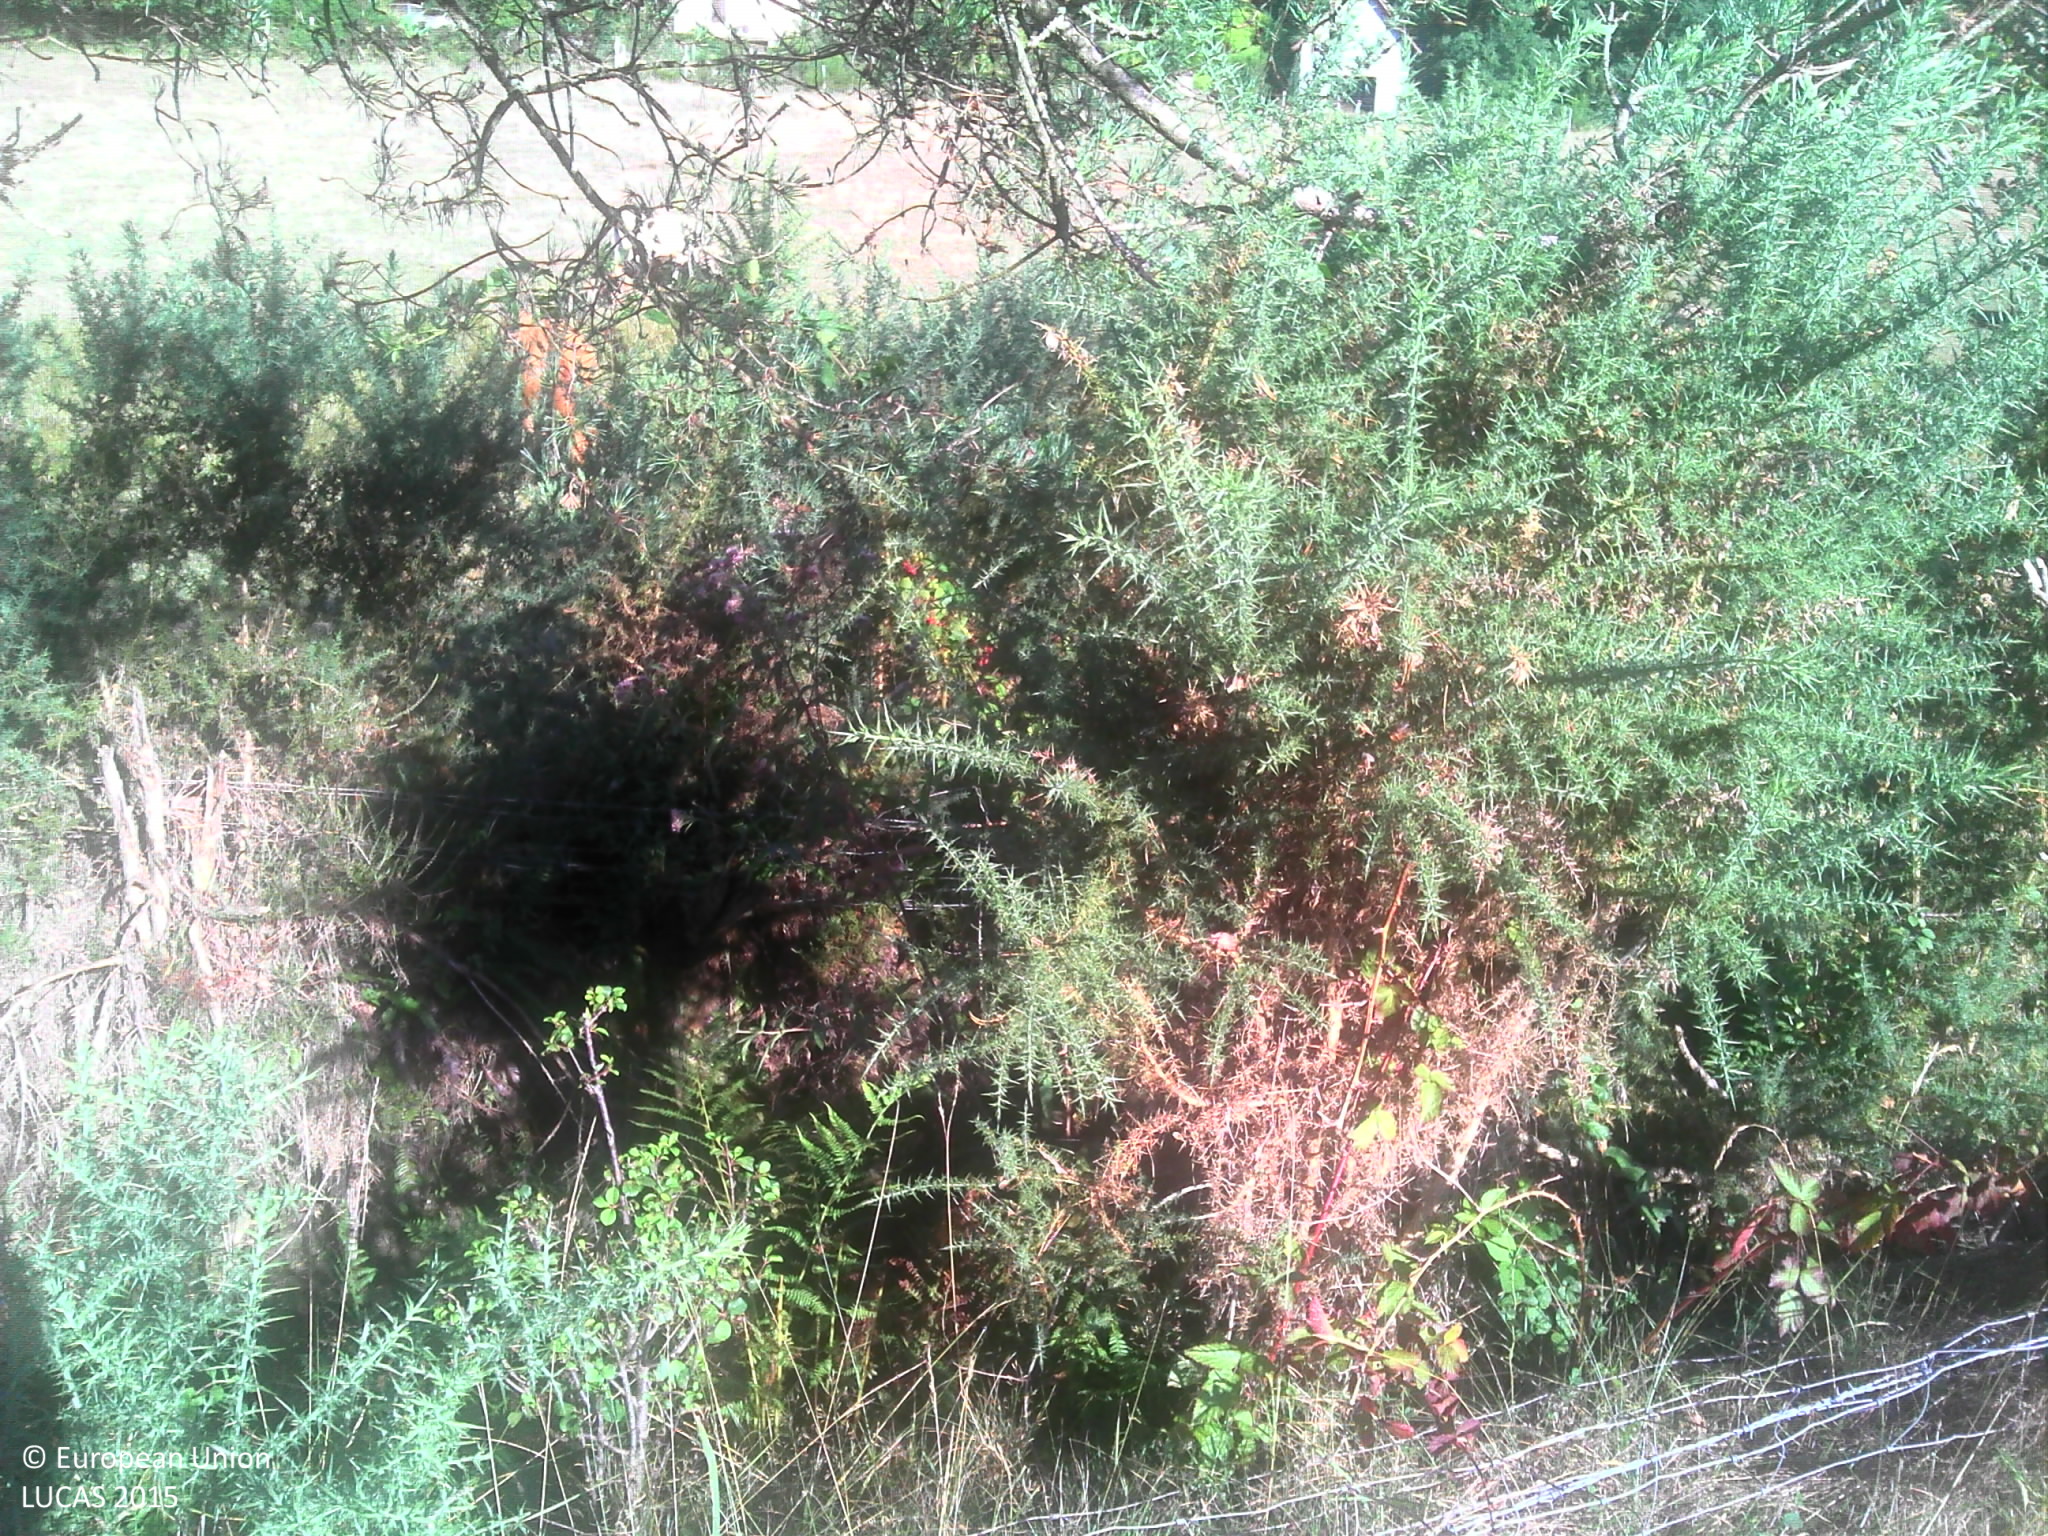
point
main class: Grassland
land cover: Grassland without tree/shrub cover
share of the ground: > 75 %
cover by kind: herbaceous plants 95 %, shrubs 5 %
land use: Agriculture (excluding fallow land and kitchen gardens)
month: August
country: FR
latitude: 45.3173
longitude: 1.8705
